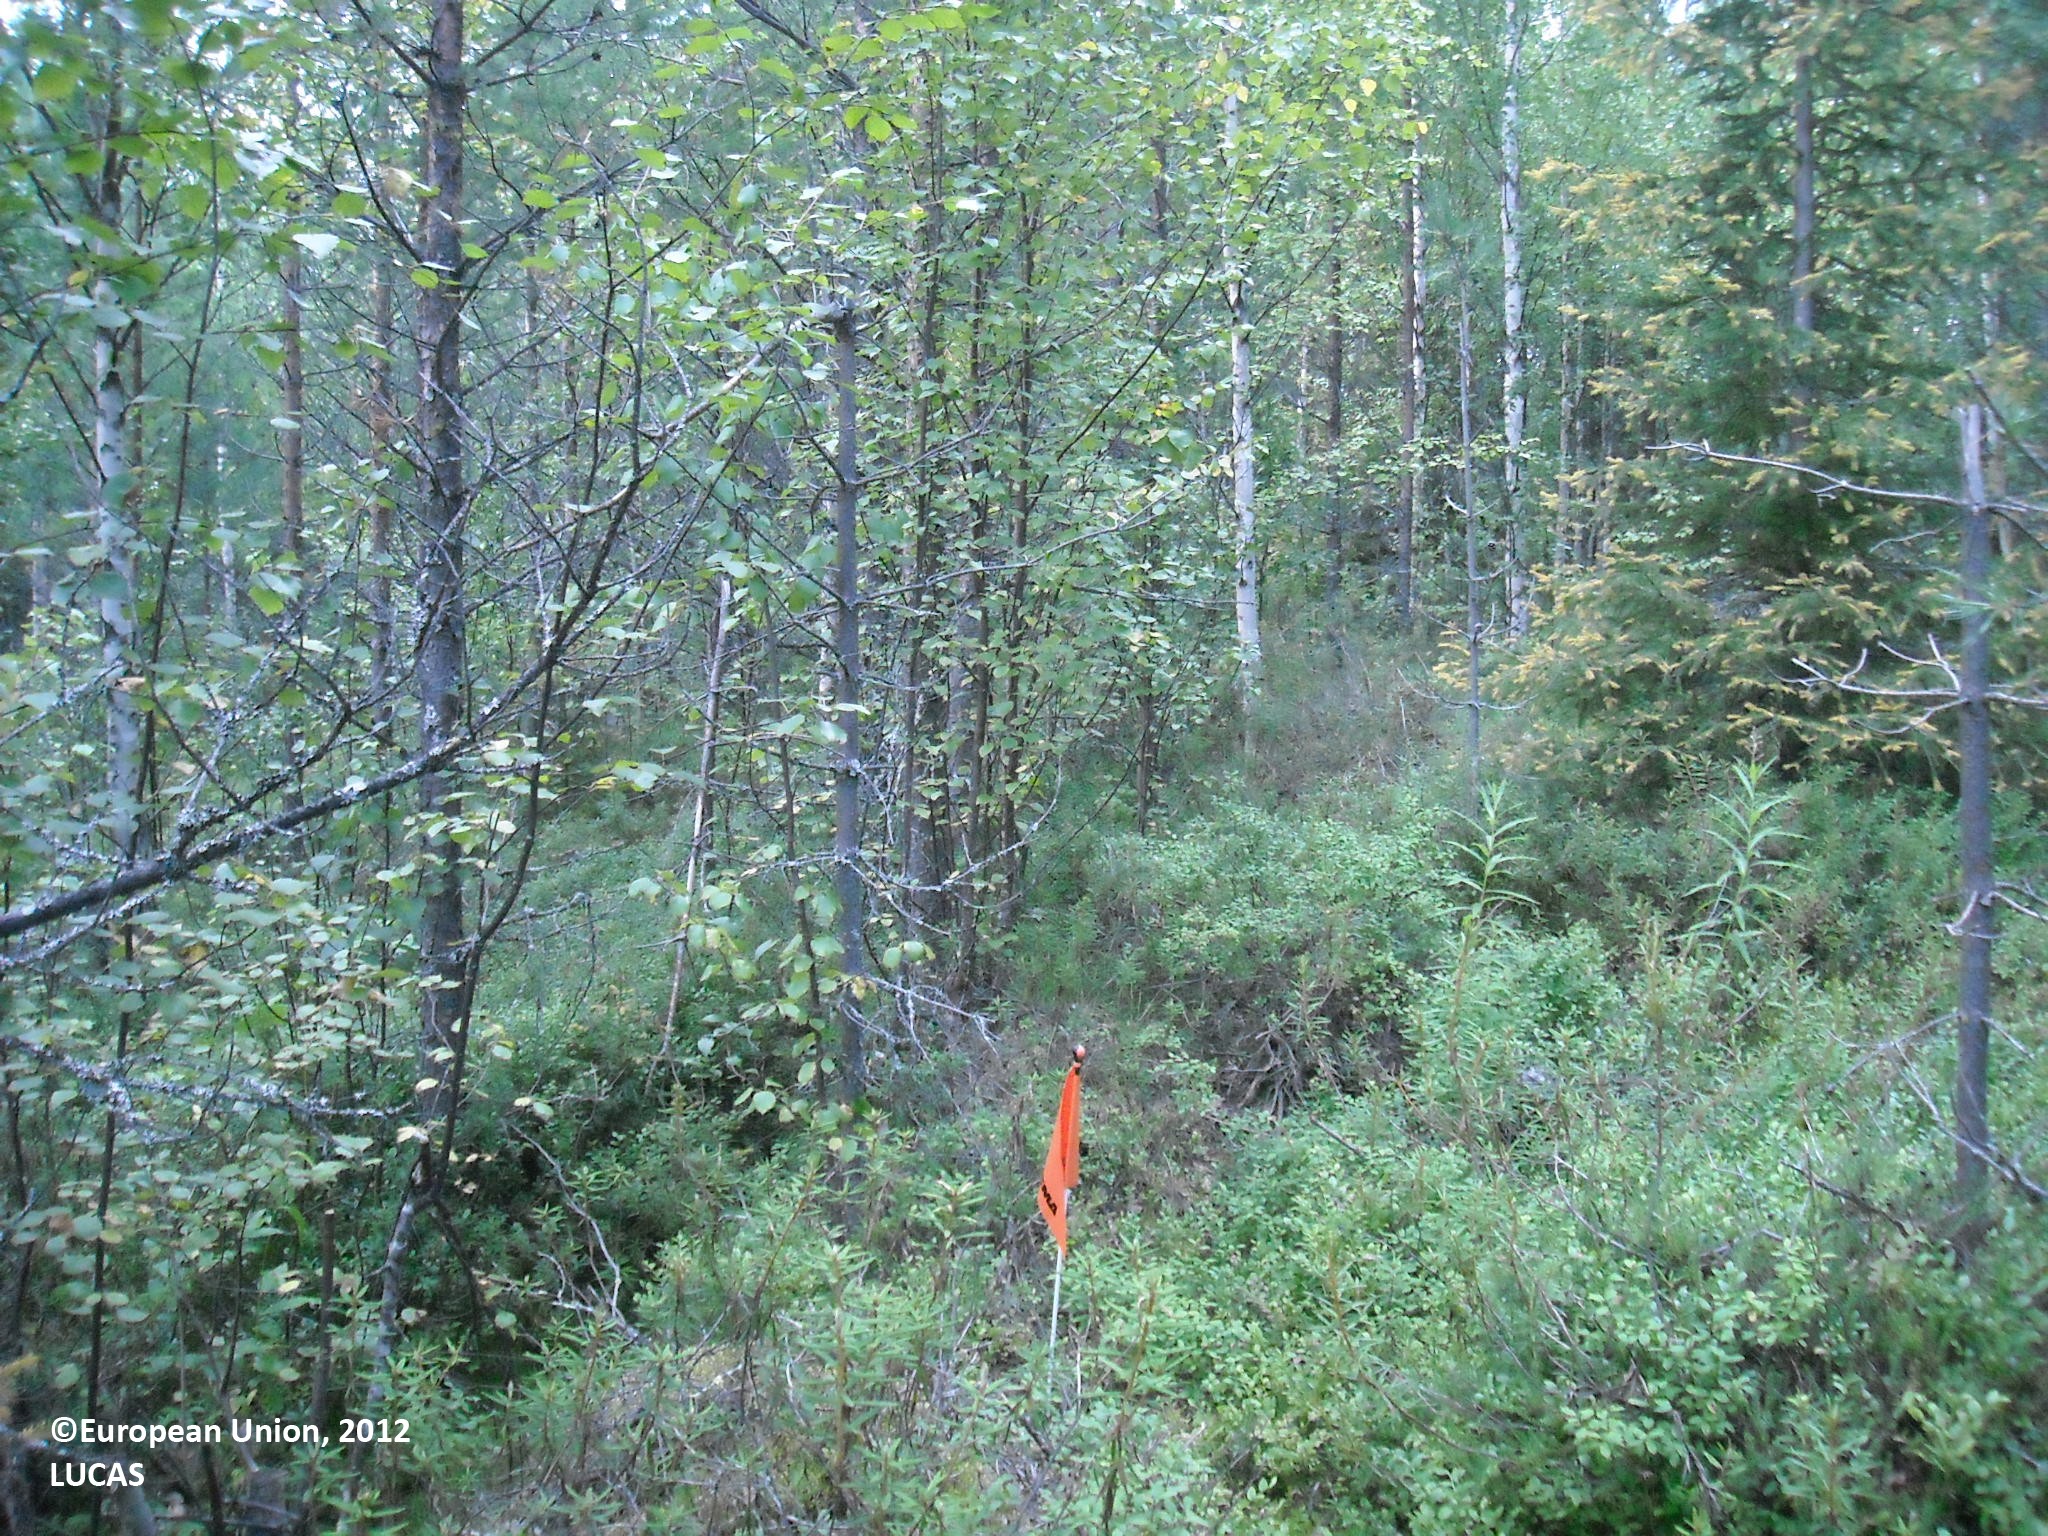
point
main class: Woodland
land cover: Other mixed woodland
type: boreal forest
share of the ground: > 75 %
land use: Forestry
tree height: > 5 m
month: August
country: FI
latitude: 65.1822
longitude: 27.6691
